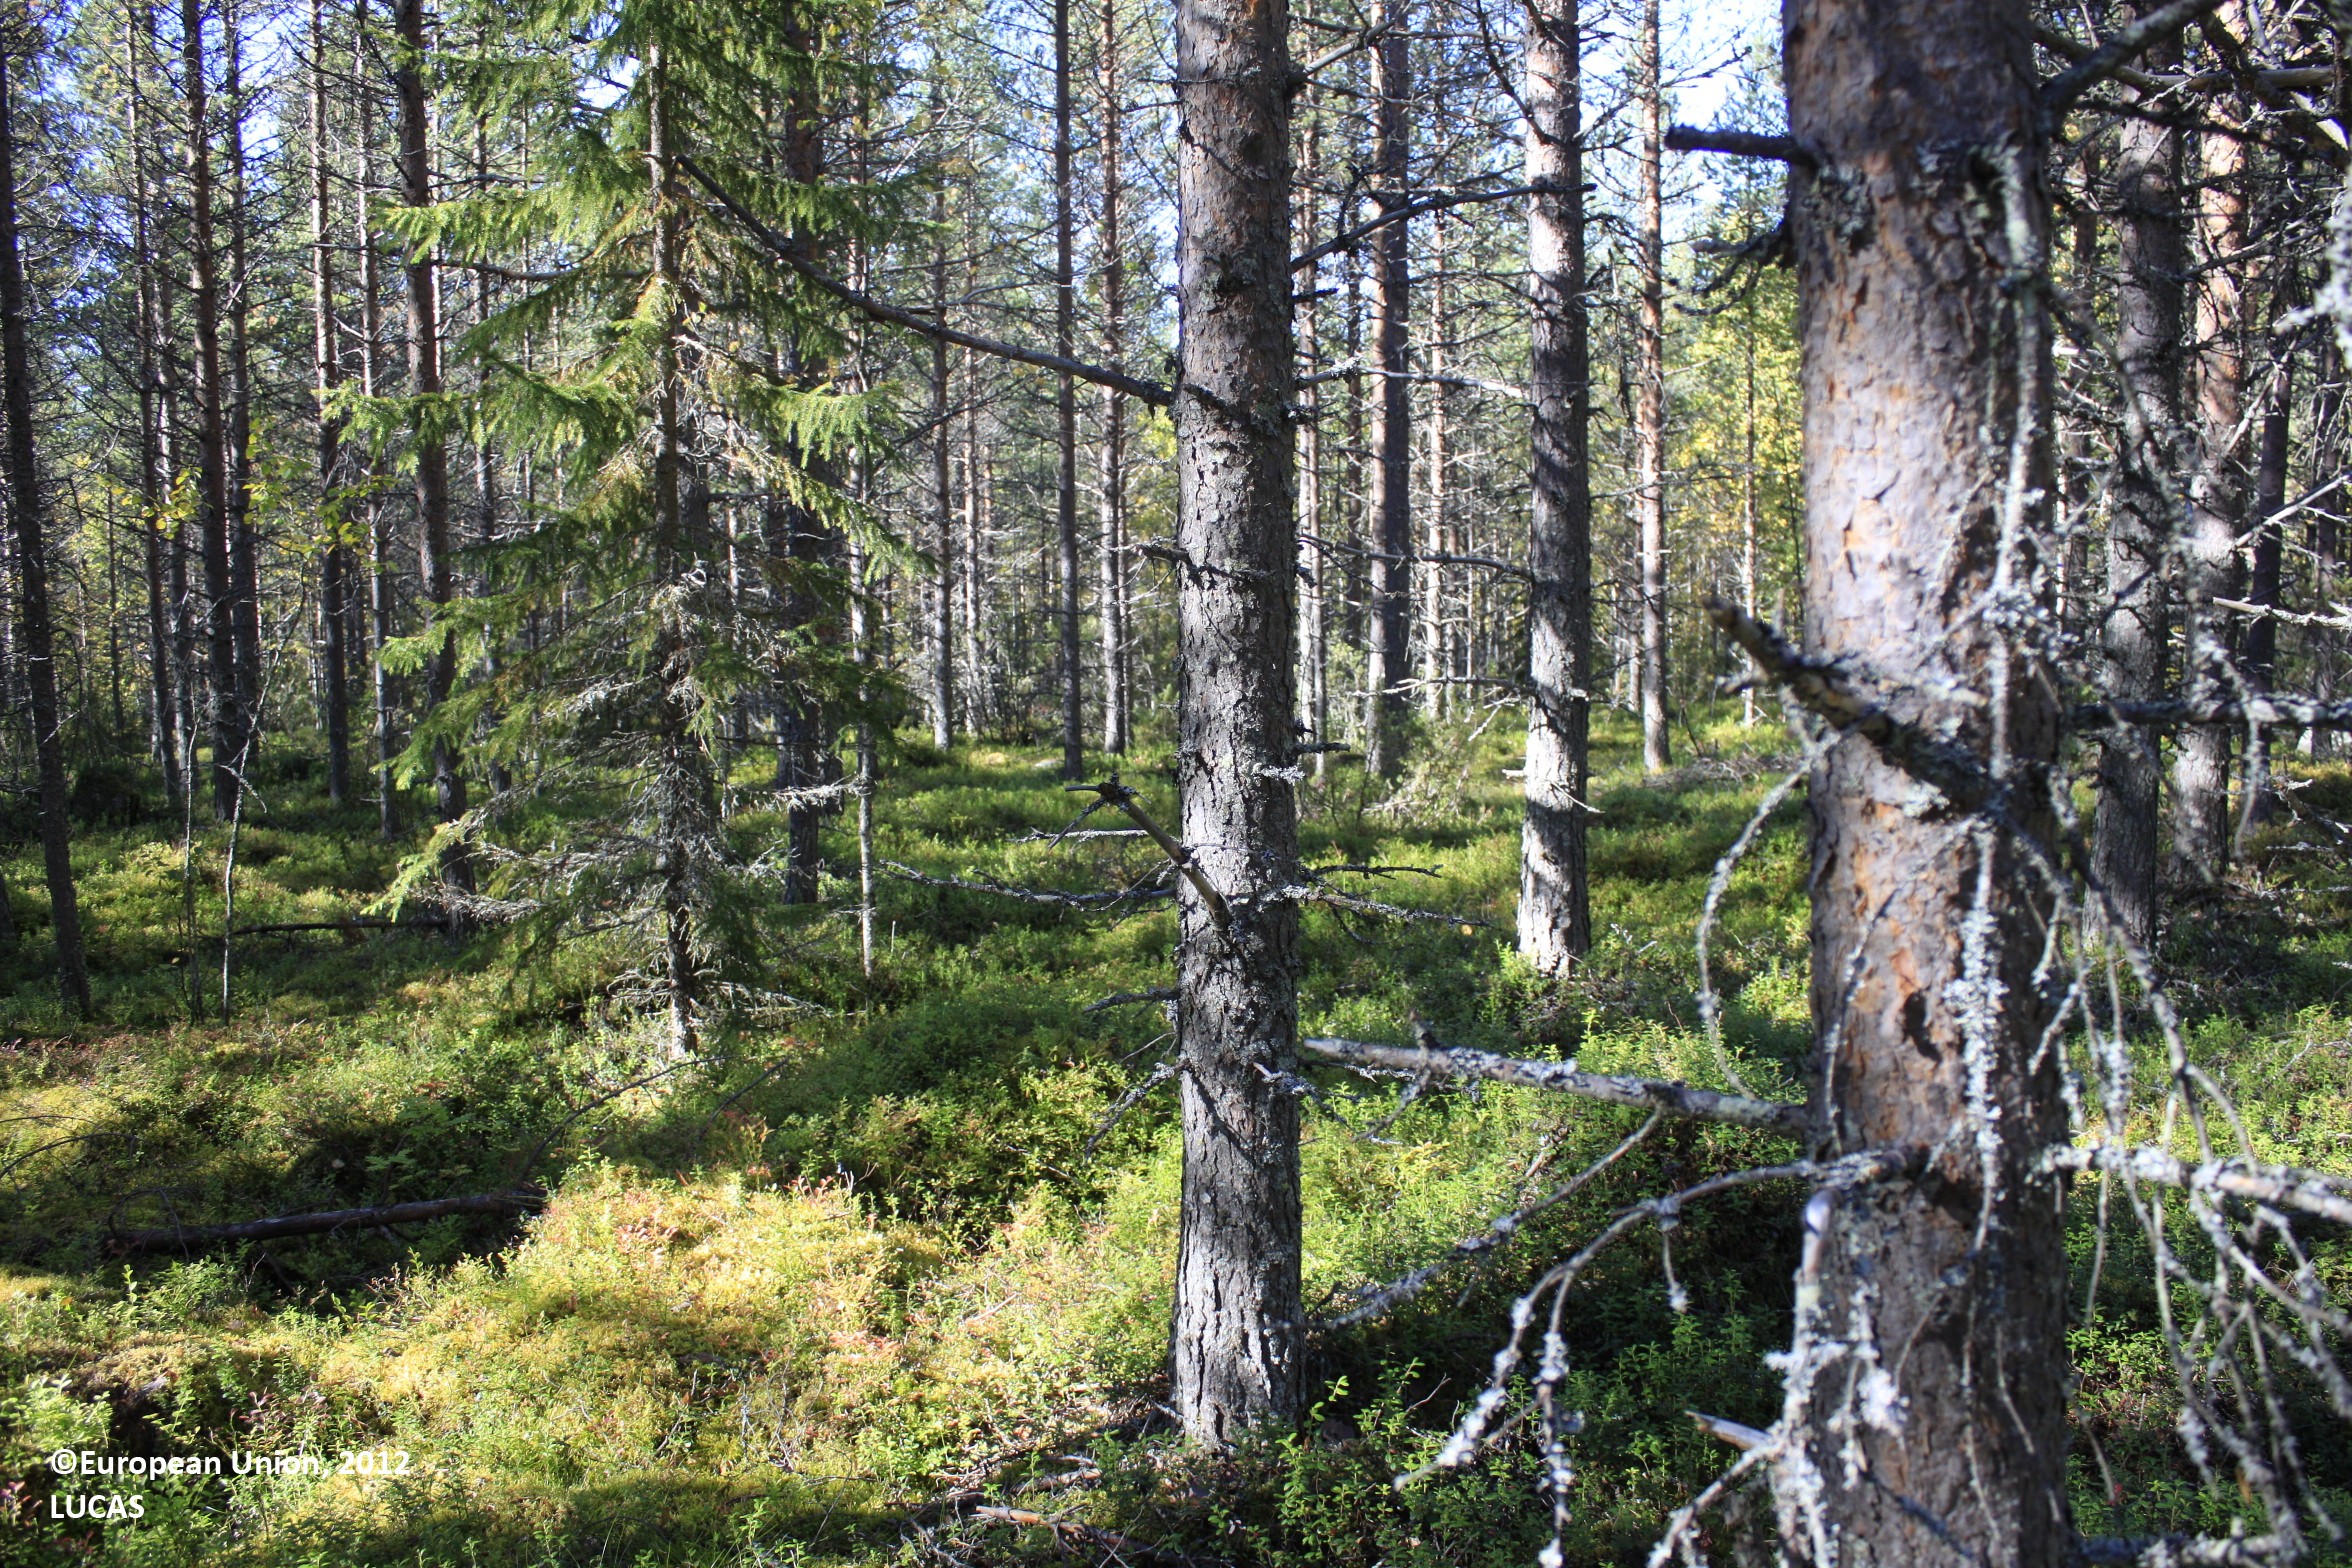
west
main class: Woodland
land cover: Pine dominated coniferous woodland
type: boreal forest
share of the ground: 25 - 50 %
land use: Forestry
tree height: > 5 m
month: September
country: FI
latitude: 65.8461
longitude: 26.8606
